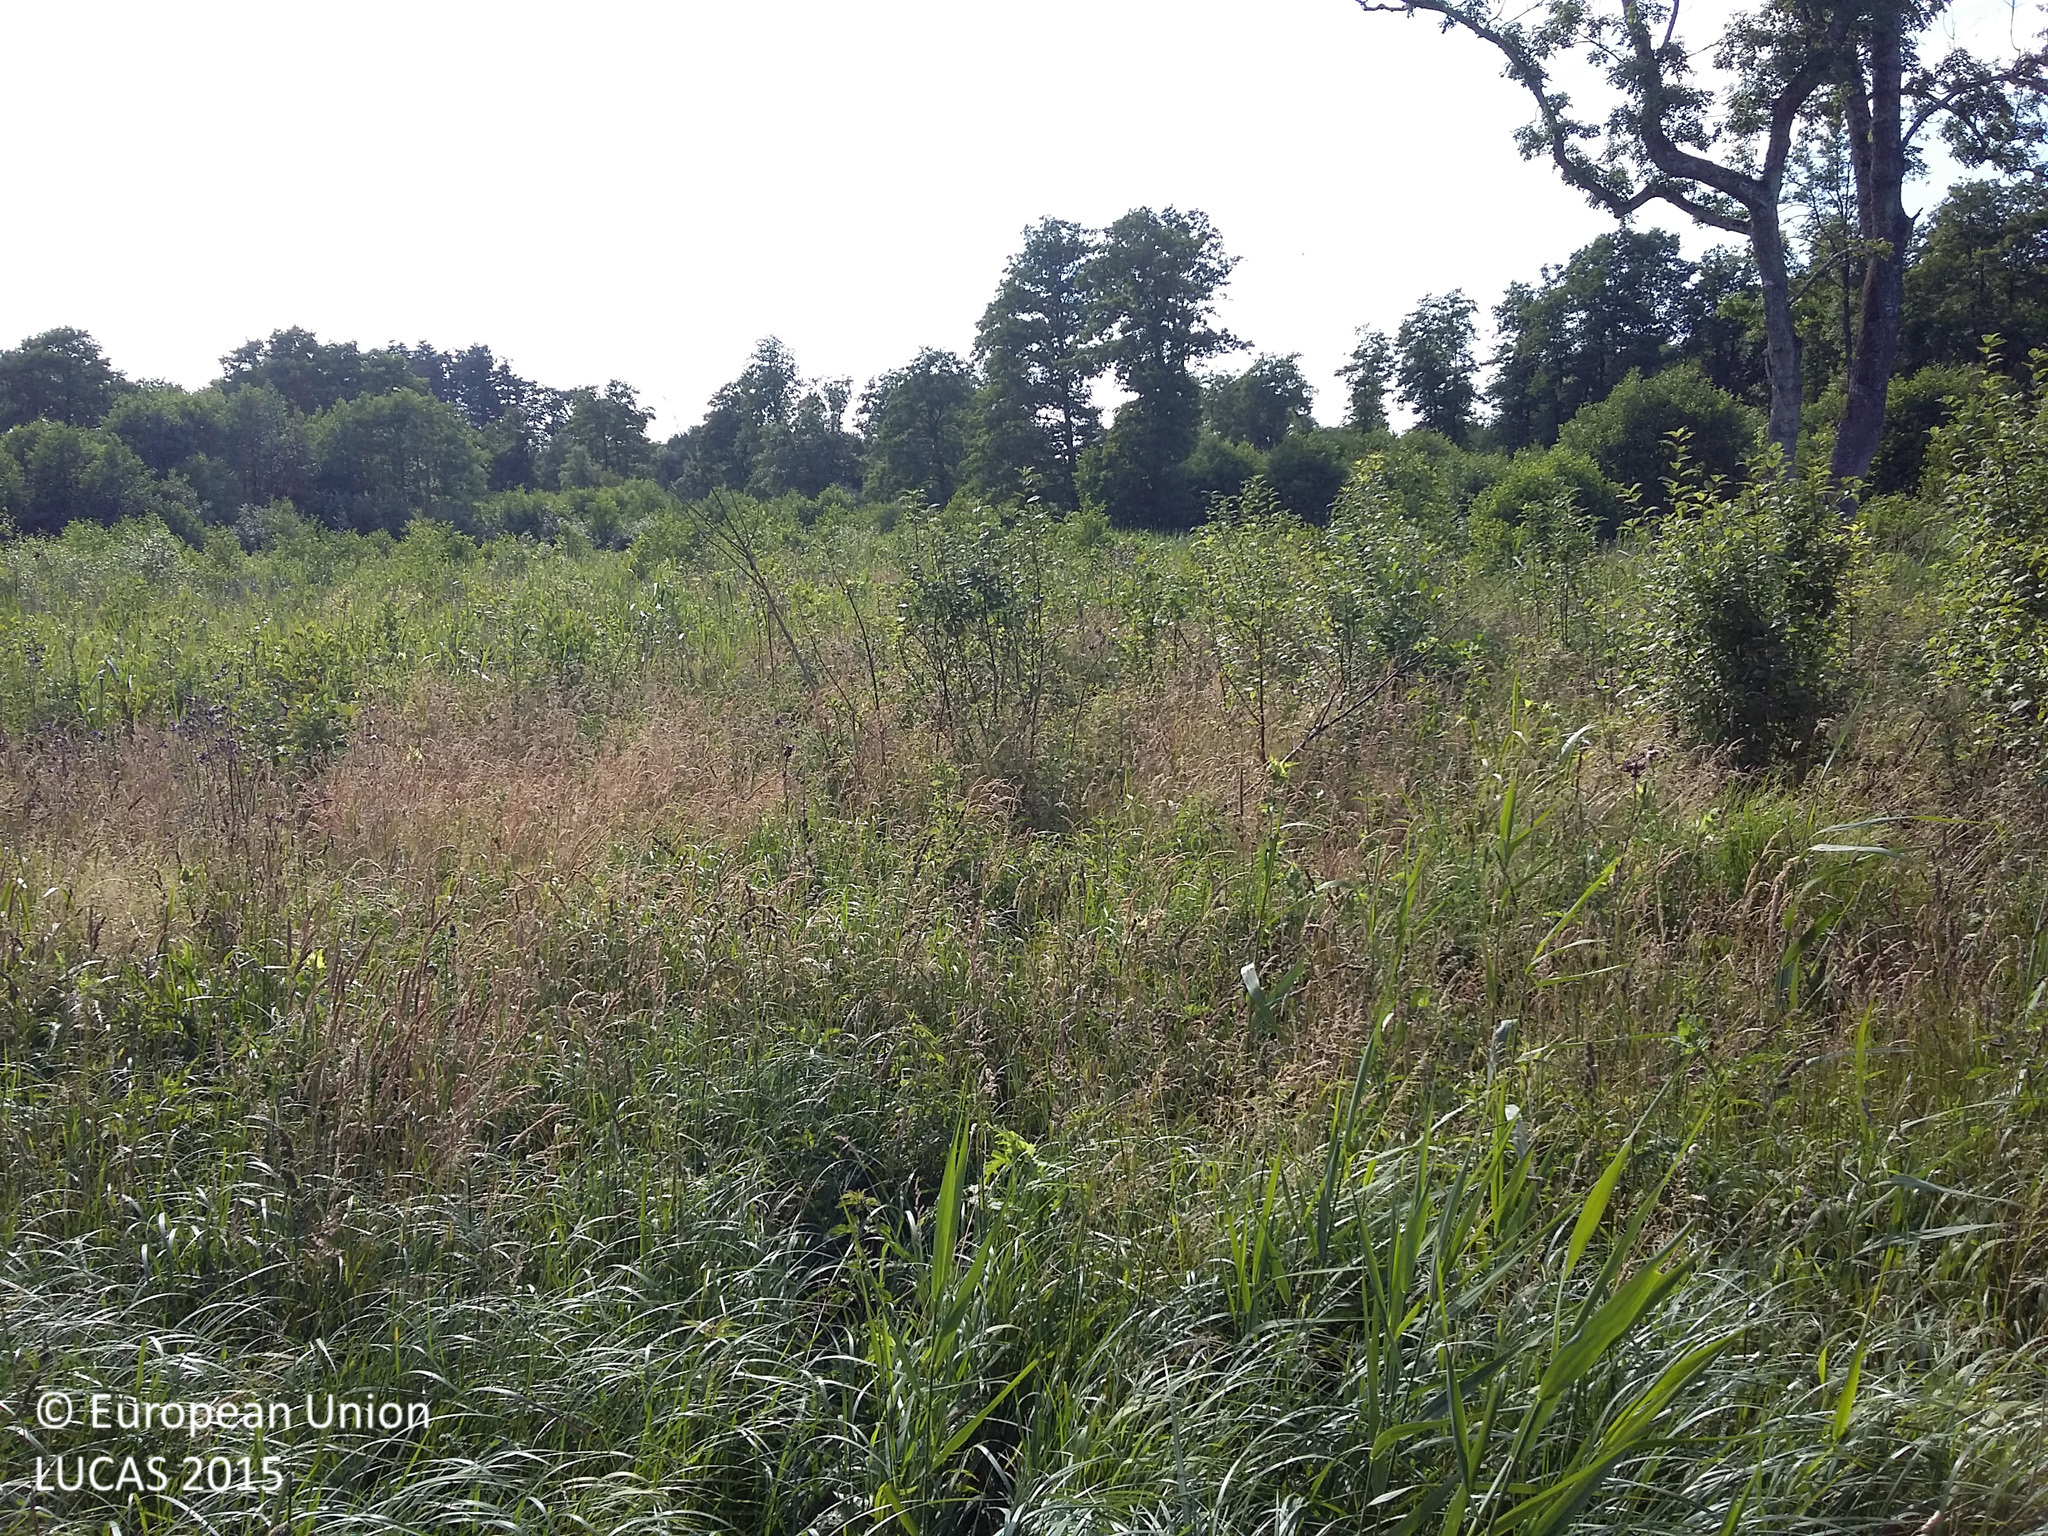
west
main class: Grassland
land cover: Grassland with sparse tree/shrub cover
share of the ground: > 75 %
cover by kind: herbaceous plants 95 %, broadleaved forest trees 5 %
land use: Forestry
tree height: > 5 m
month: July
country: DK
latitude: 55.6227
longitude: 11.4120
